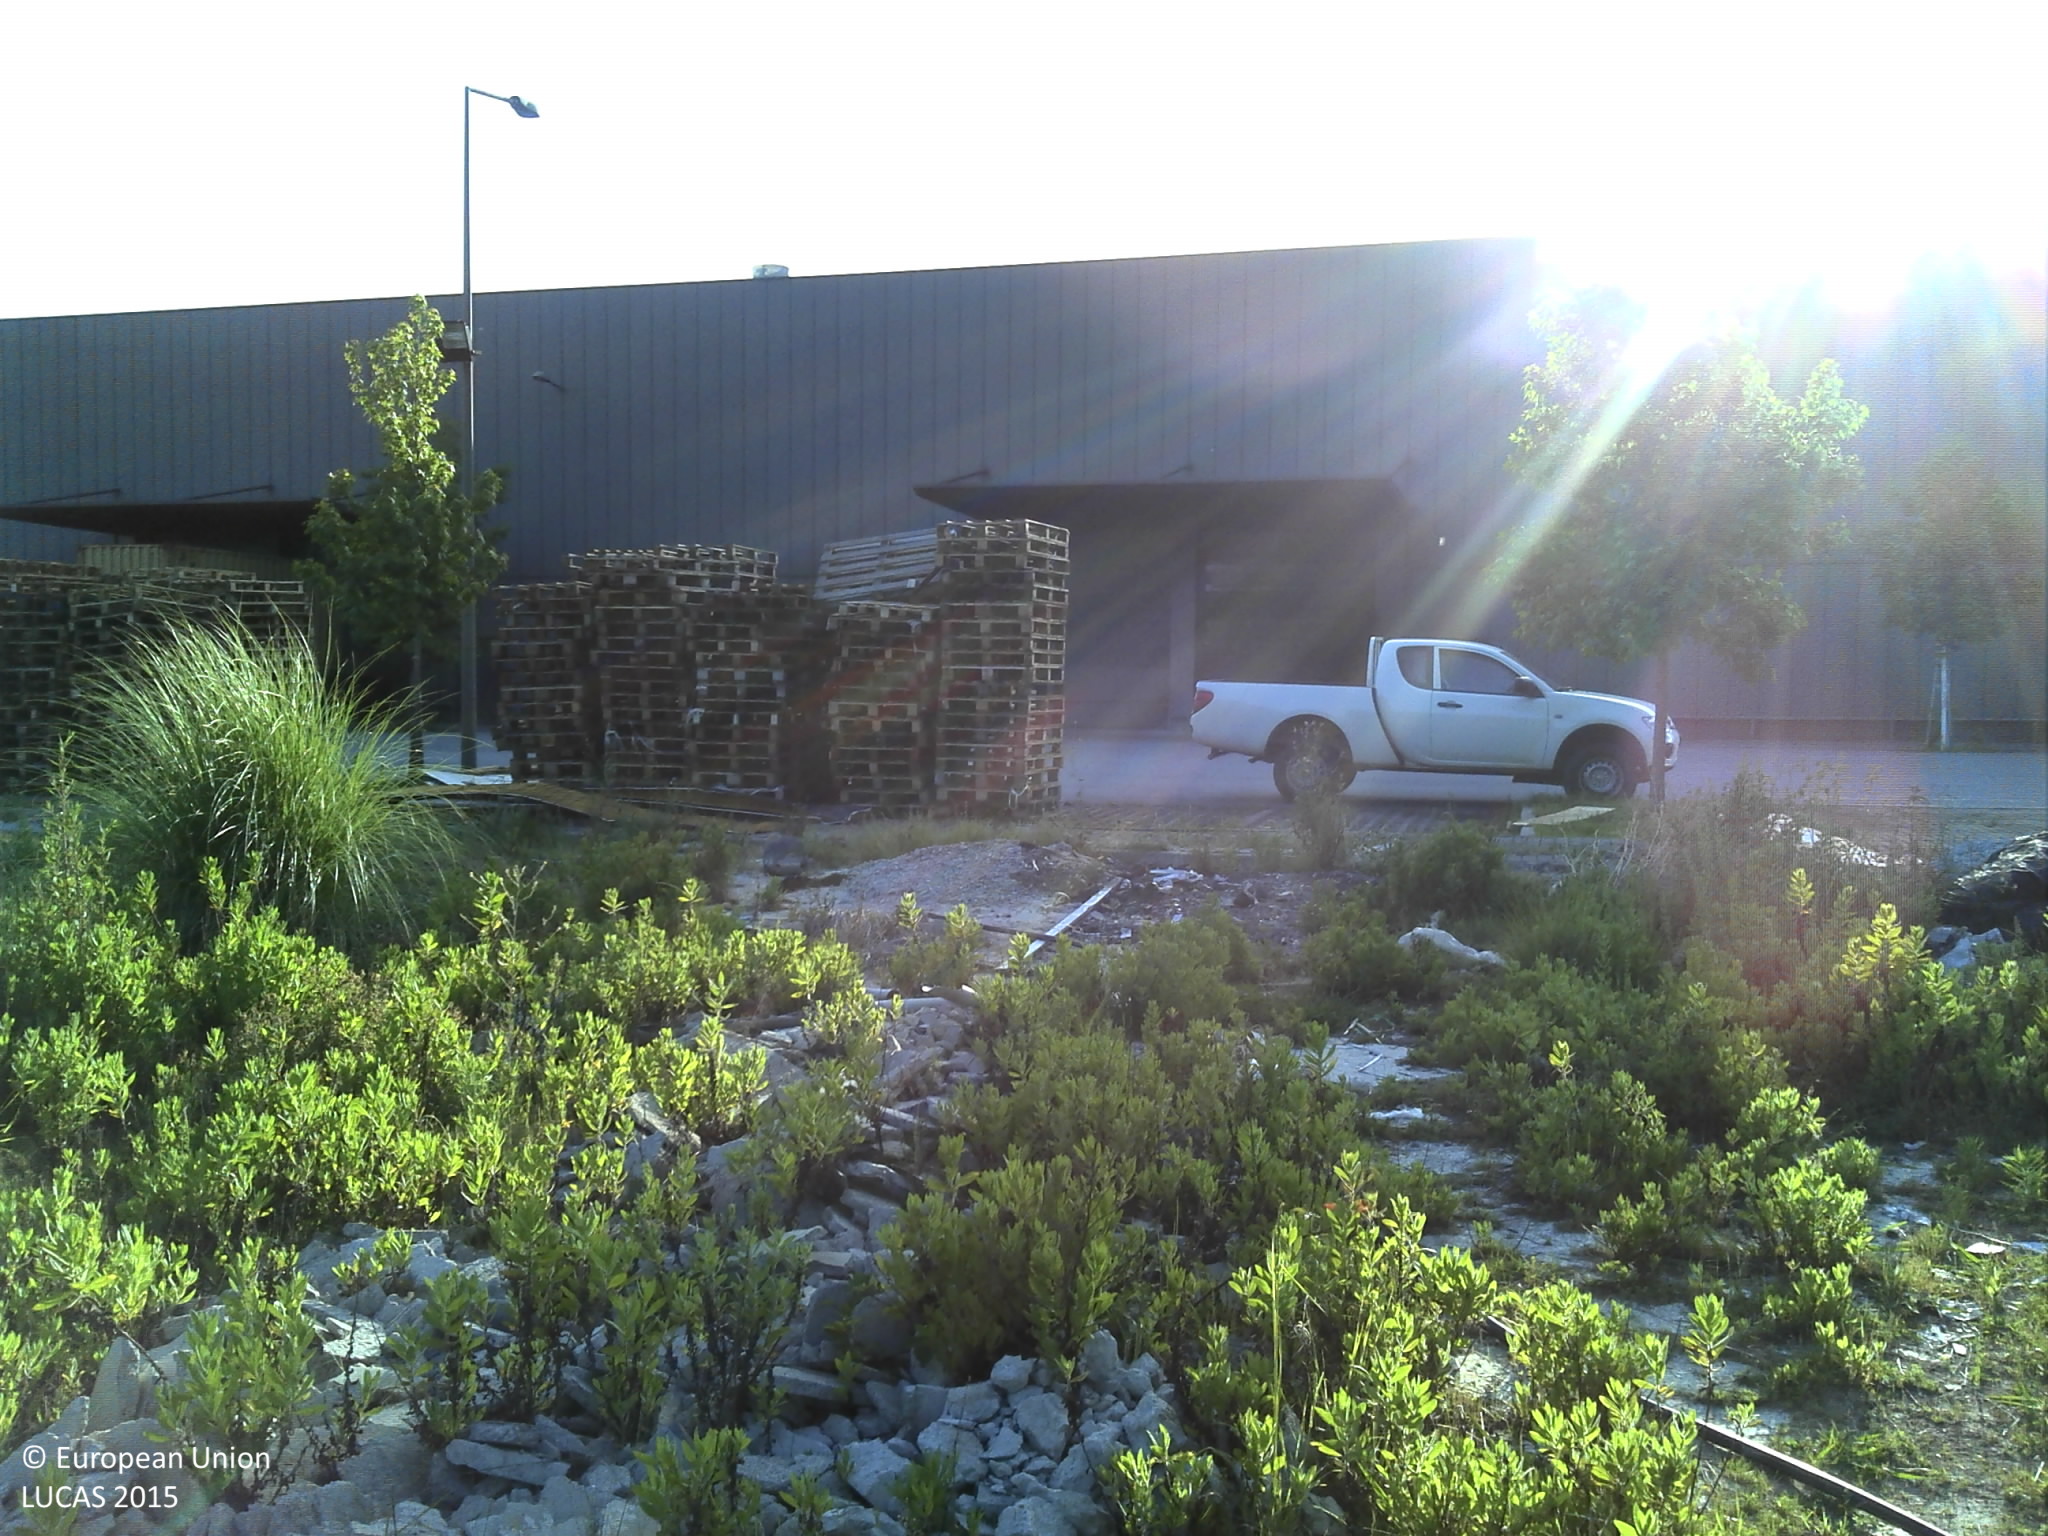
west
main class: Grassland
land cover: Spontaneously vegetated surfaces
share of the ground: 25 - 50 %
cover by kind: herbaceous plants 50 %, unconsolidated bare surface 50 %
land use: Abandoned areas
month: May
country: PT
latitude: 41.3700
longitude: -8.5297
